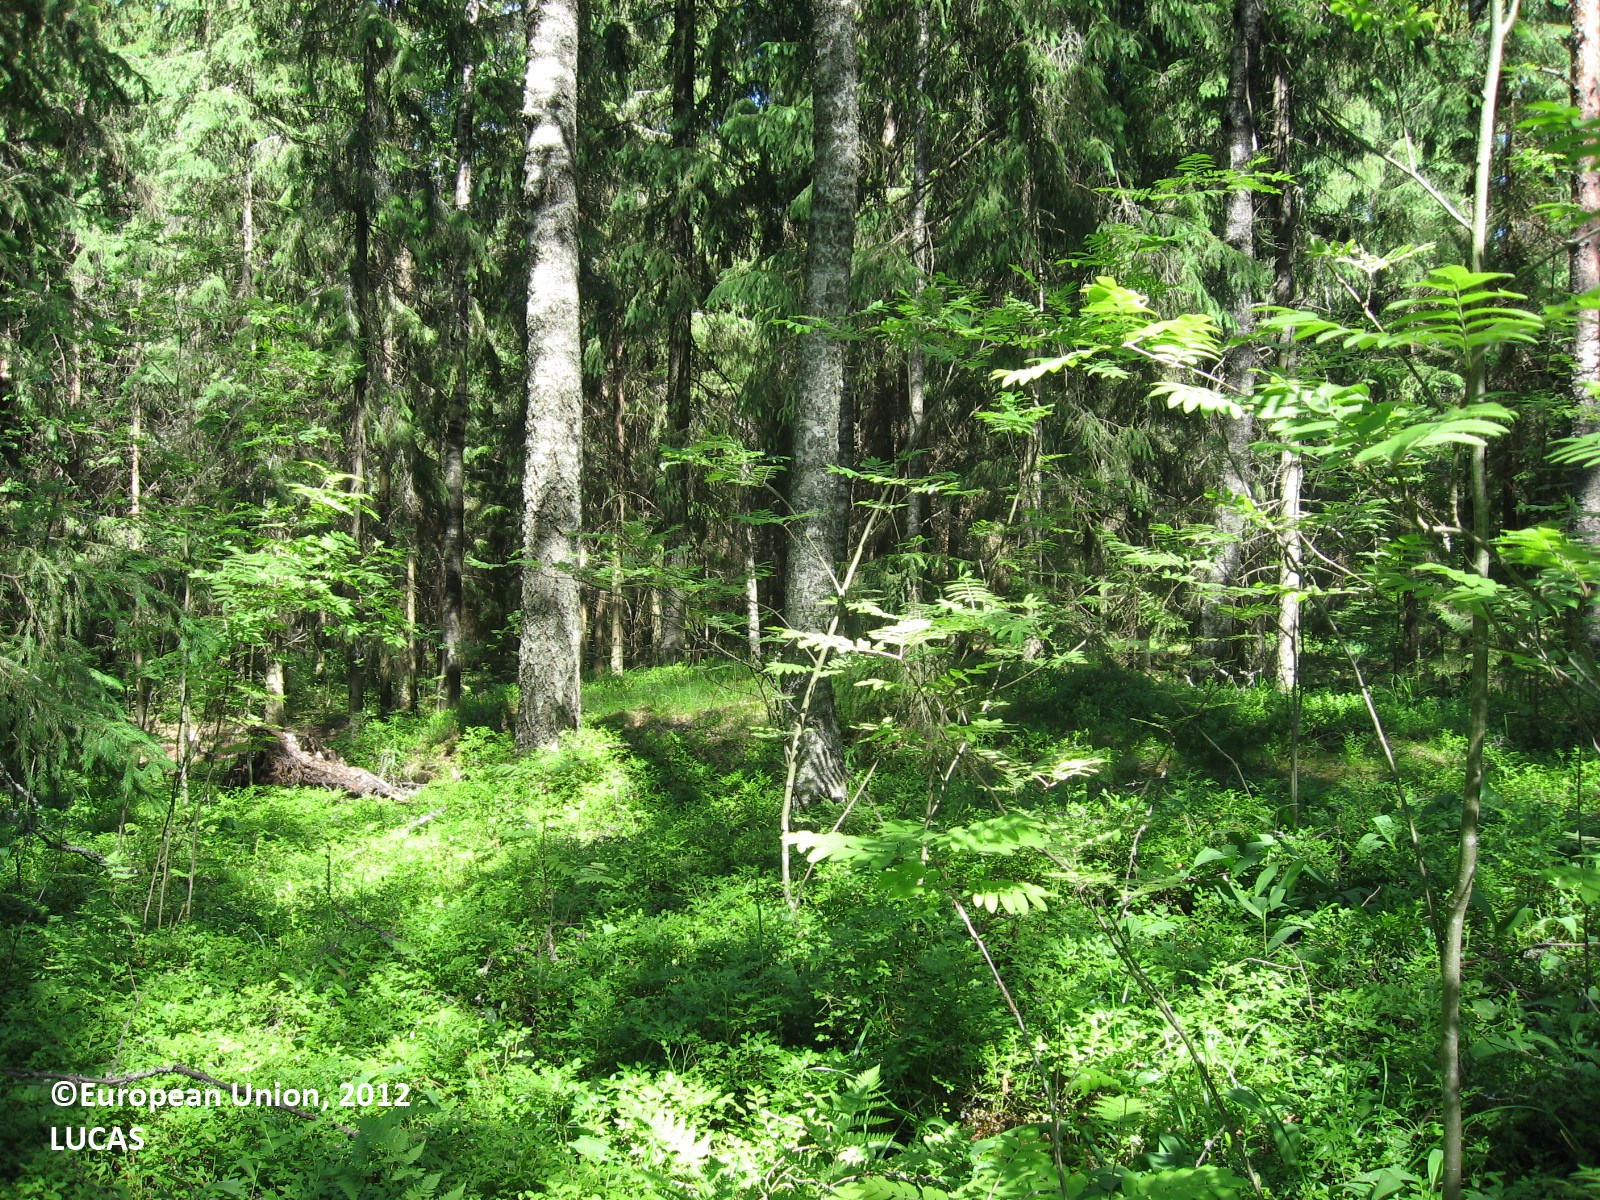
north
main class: Woodland
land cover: Spruce dominated mixed woodland
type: boreal forest
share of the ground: > 75 %
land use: Forestry
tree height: > 5 m
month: June
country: FI
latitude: 60.5643
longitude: 25.0208
